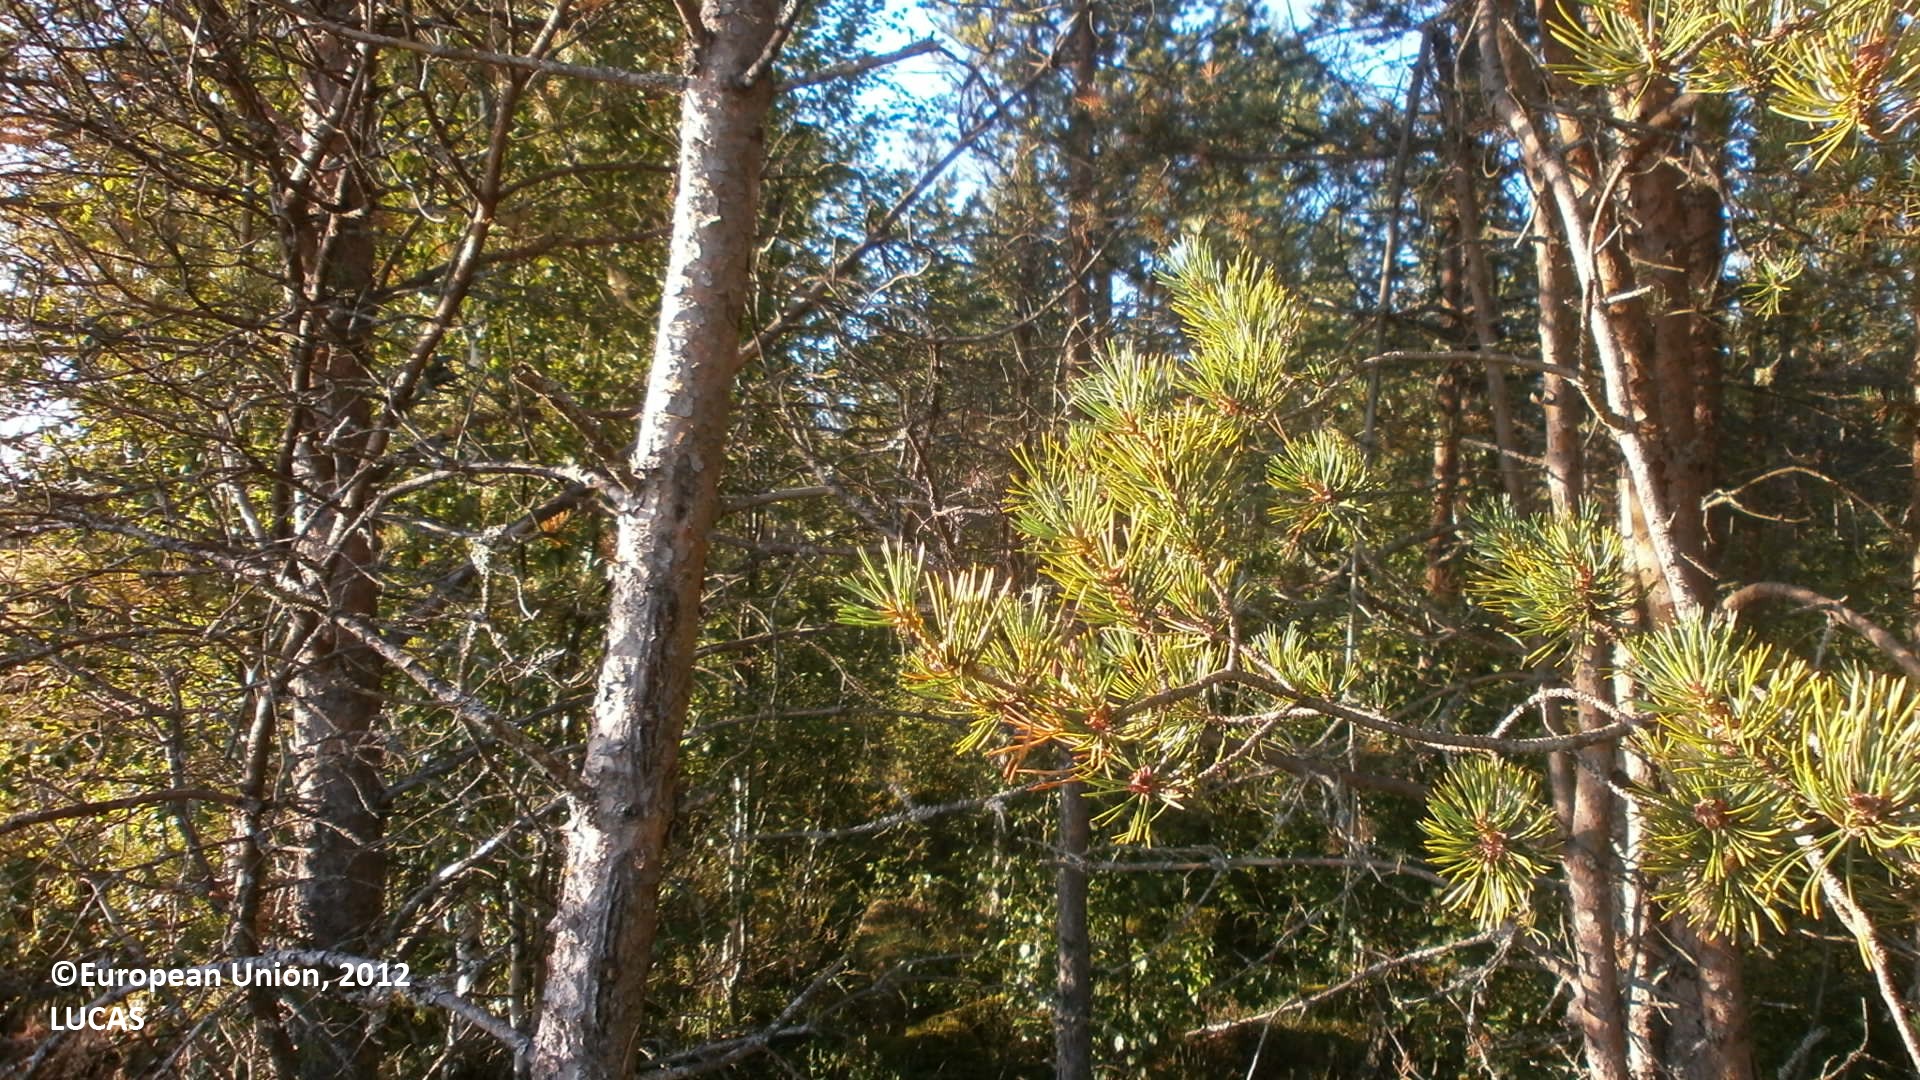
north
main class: Woodland
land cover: Pine dominated mixed woodland
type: boreal forest
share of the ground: 50 - 75 %
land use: Forestry
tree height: > 5 m
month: July
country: FI
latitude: 64.0412
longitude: 24.0927
